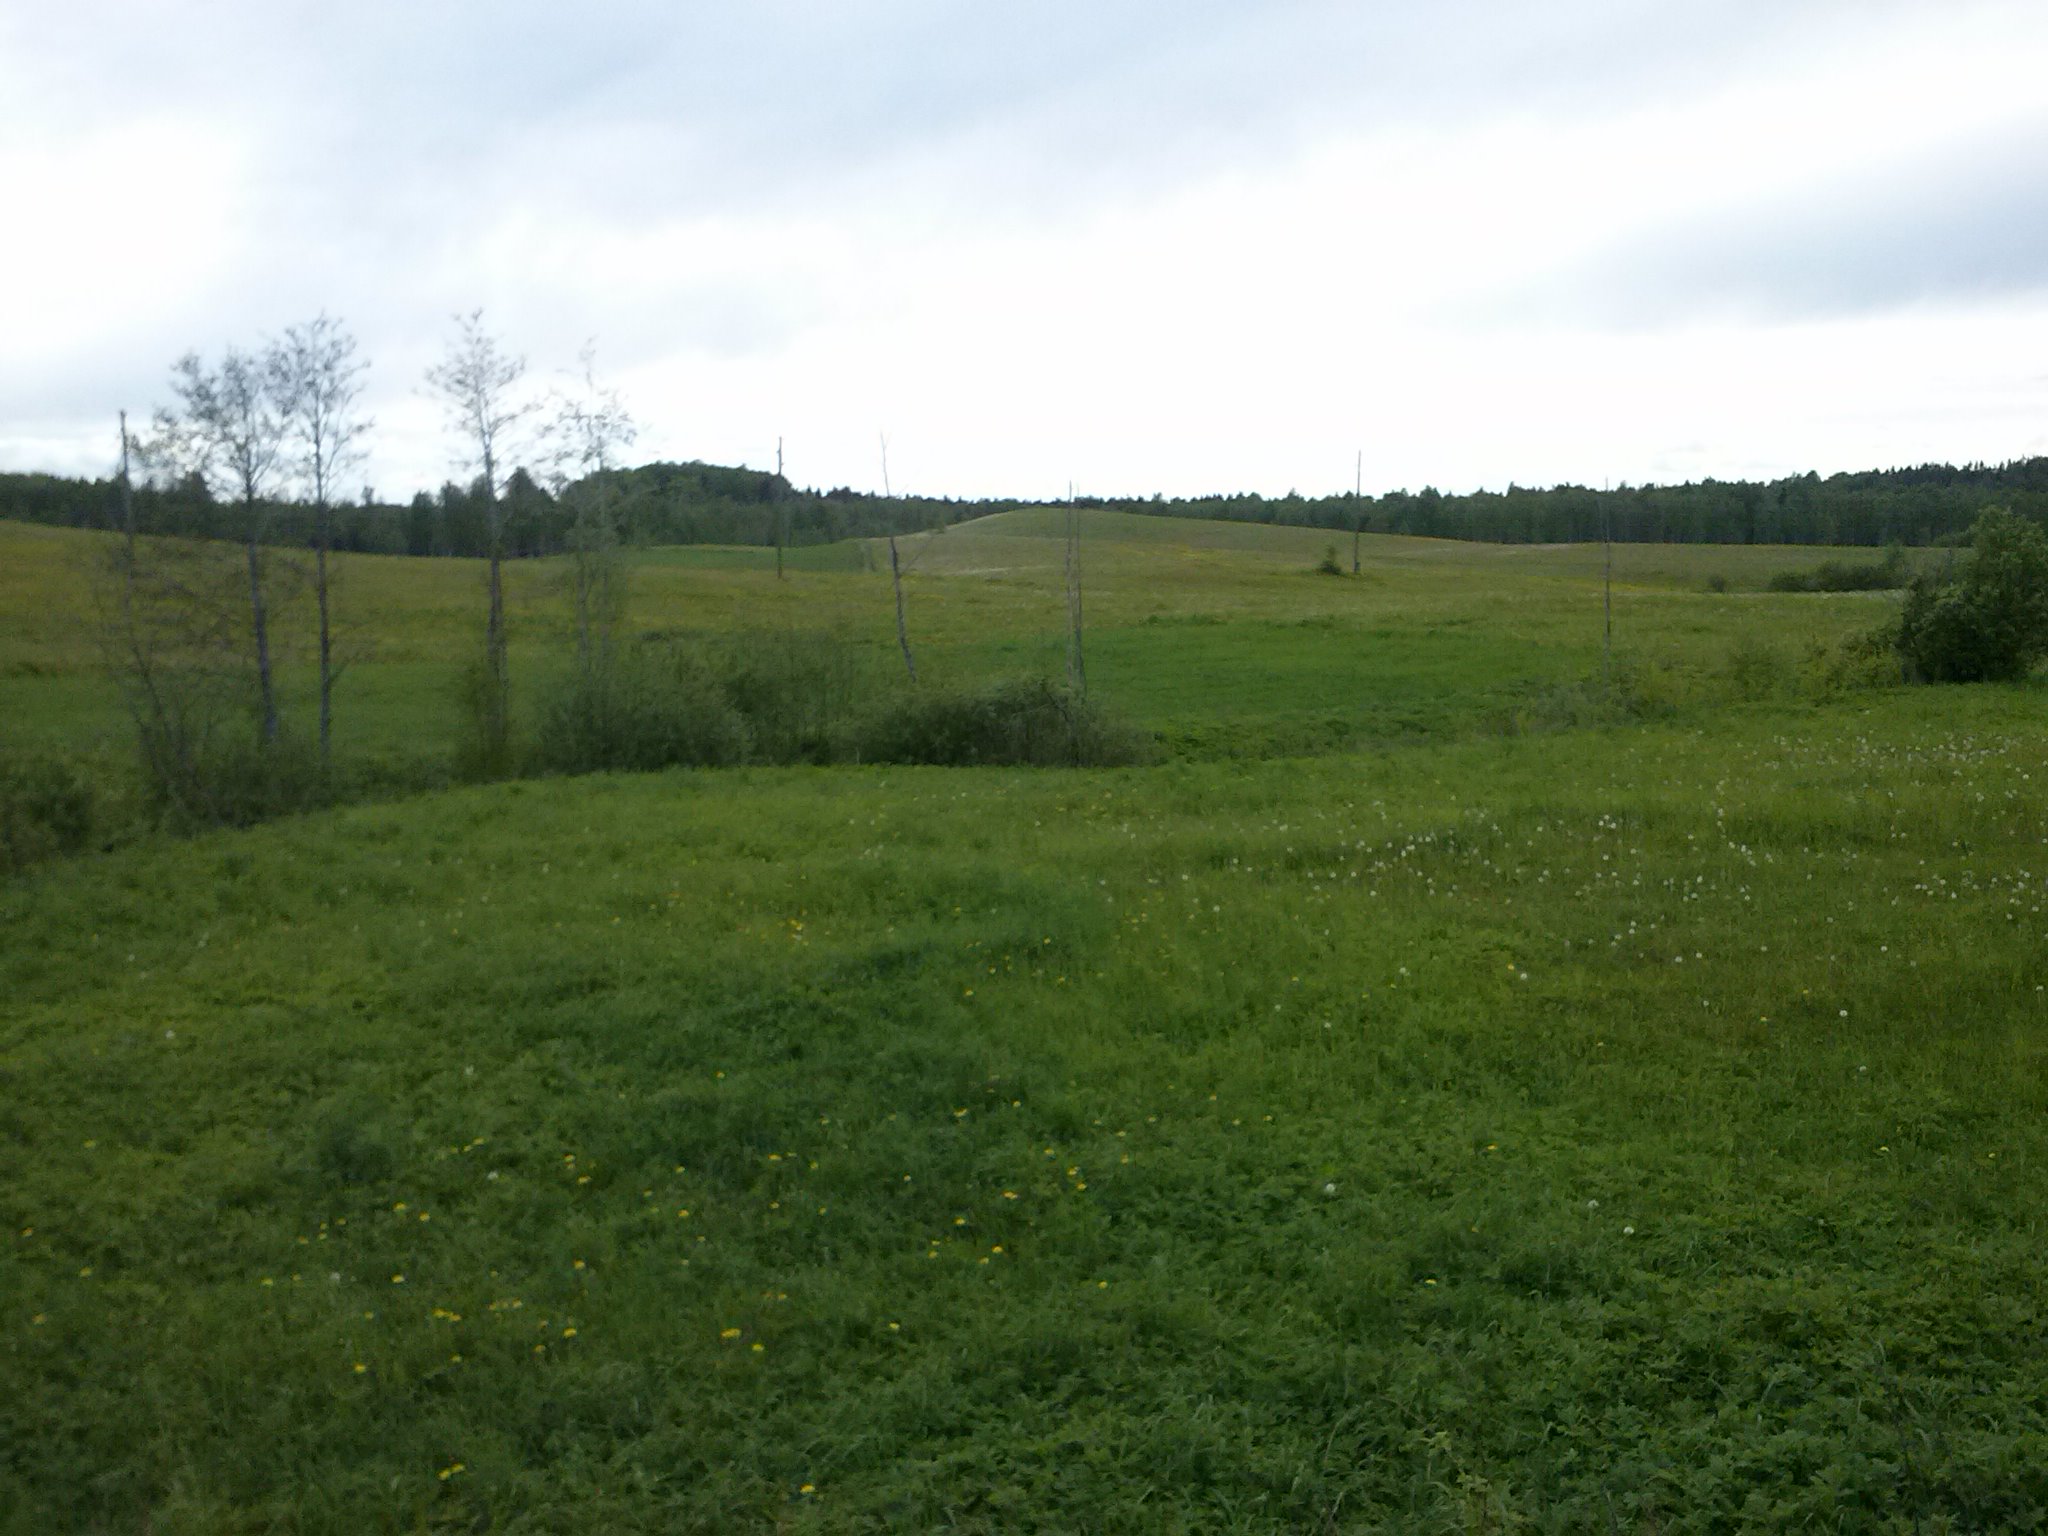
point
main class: Grassland
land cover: Grassland without tree/shrub cover
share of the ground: > 75 %
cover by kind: herbaceous plants 100 %
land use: Agriculture (excluding fallow land and kitchen gardens)
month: May
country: LV
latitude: 56.2617
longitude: 27.7705
